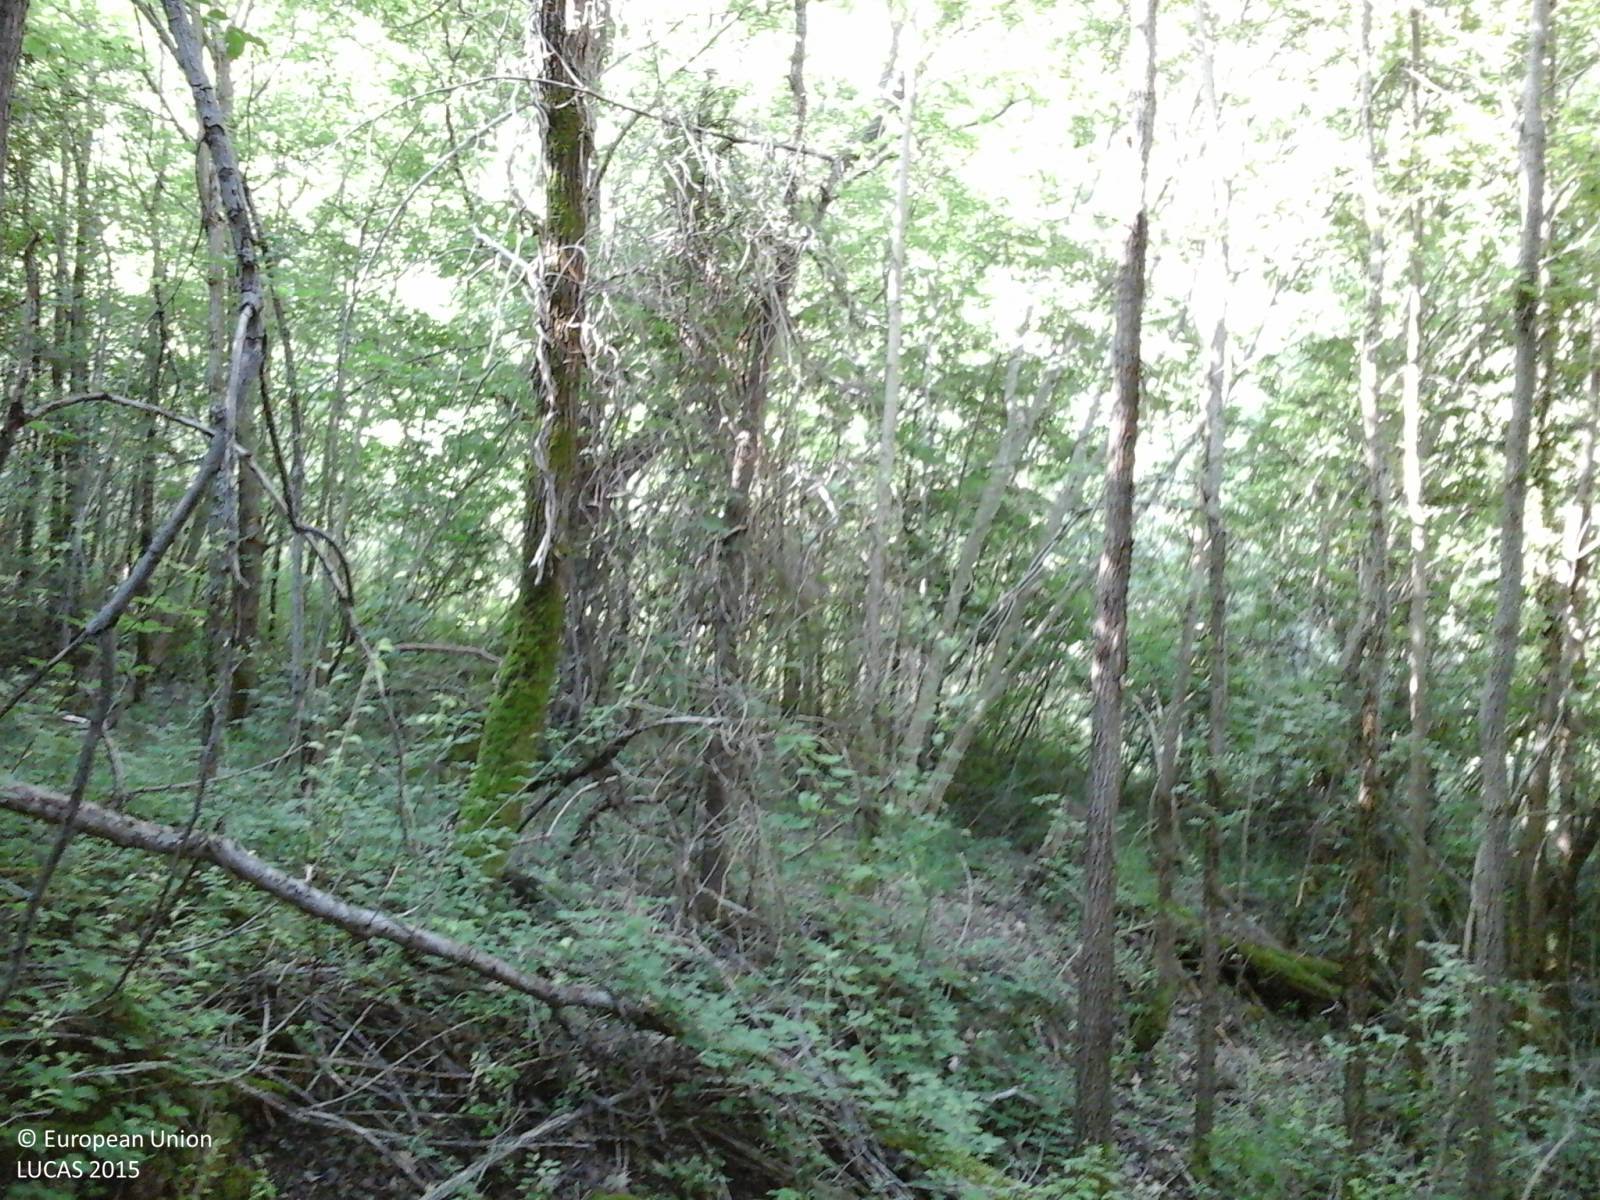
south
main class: Woodland
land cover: Broadleaved woodland
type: thermophilous deciduous forest
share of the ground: > 75 %
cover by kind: broadleaved forest trees 100 %
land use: Forestry
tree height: > 5 m
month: June
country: IT
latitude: 41.9855
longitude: 13.8133
